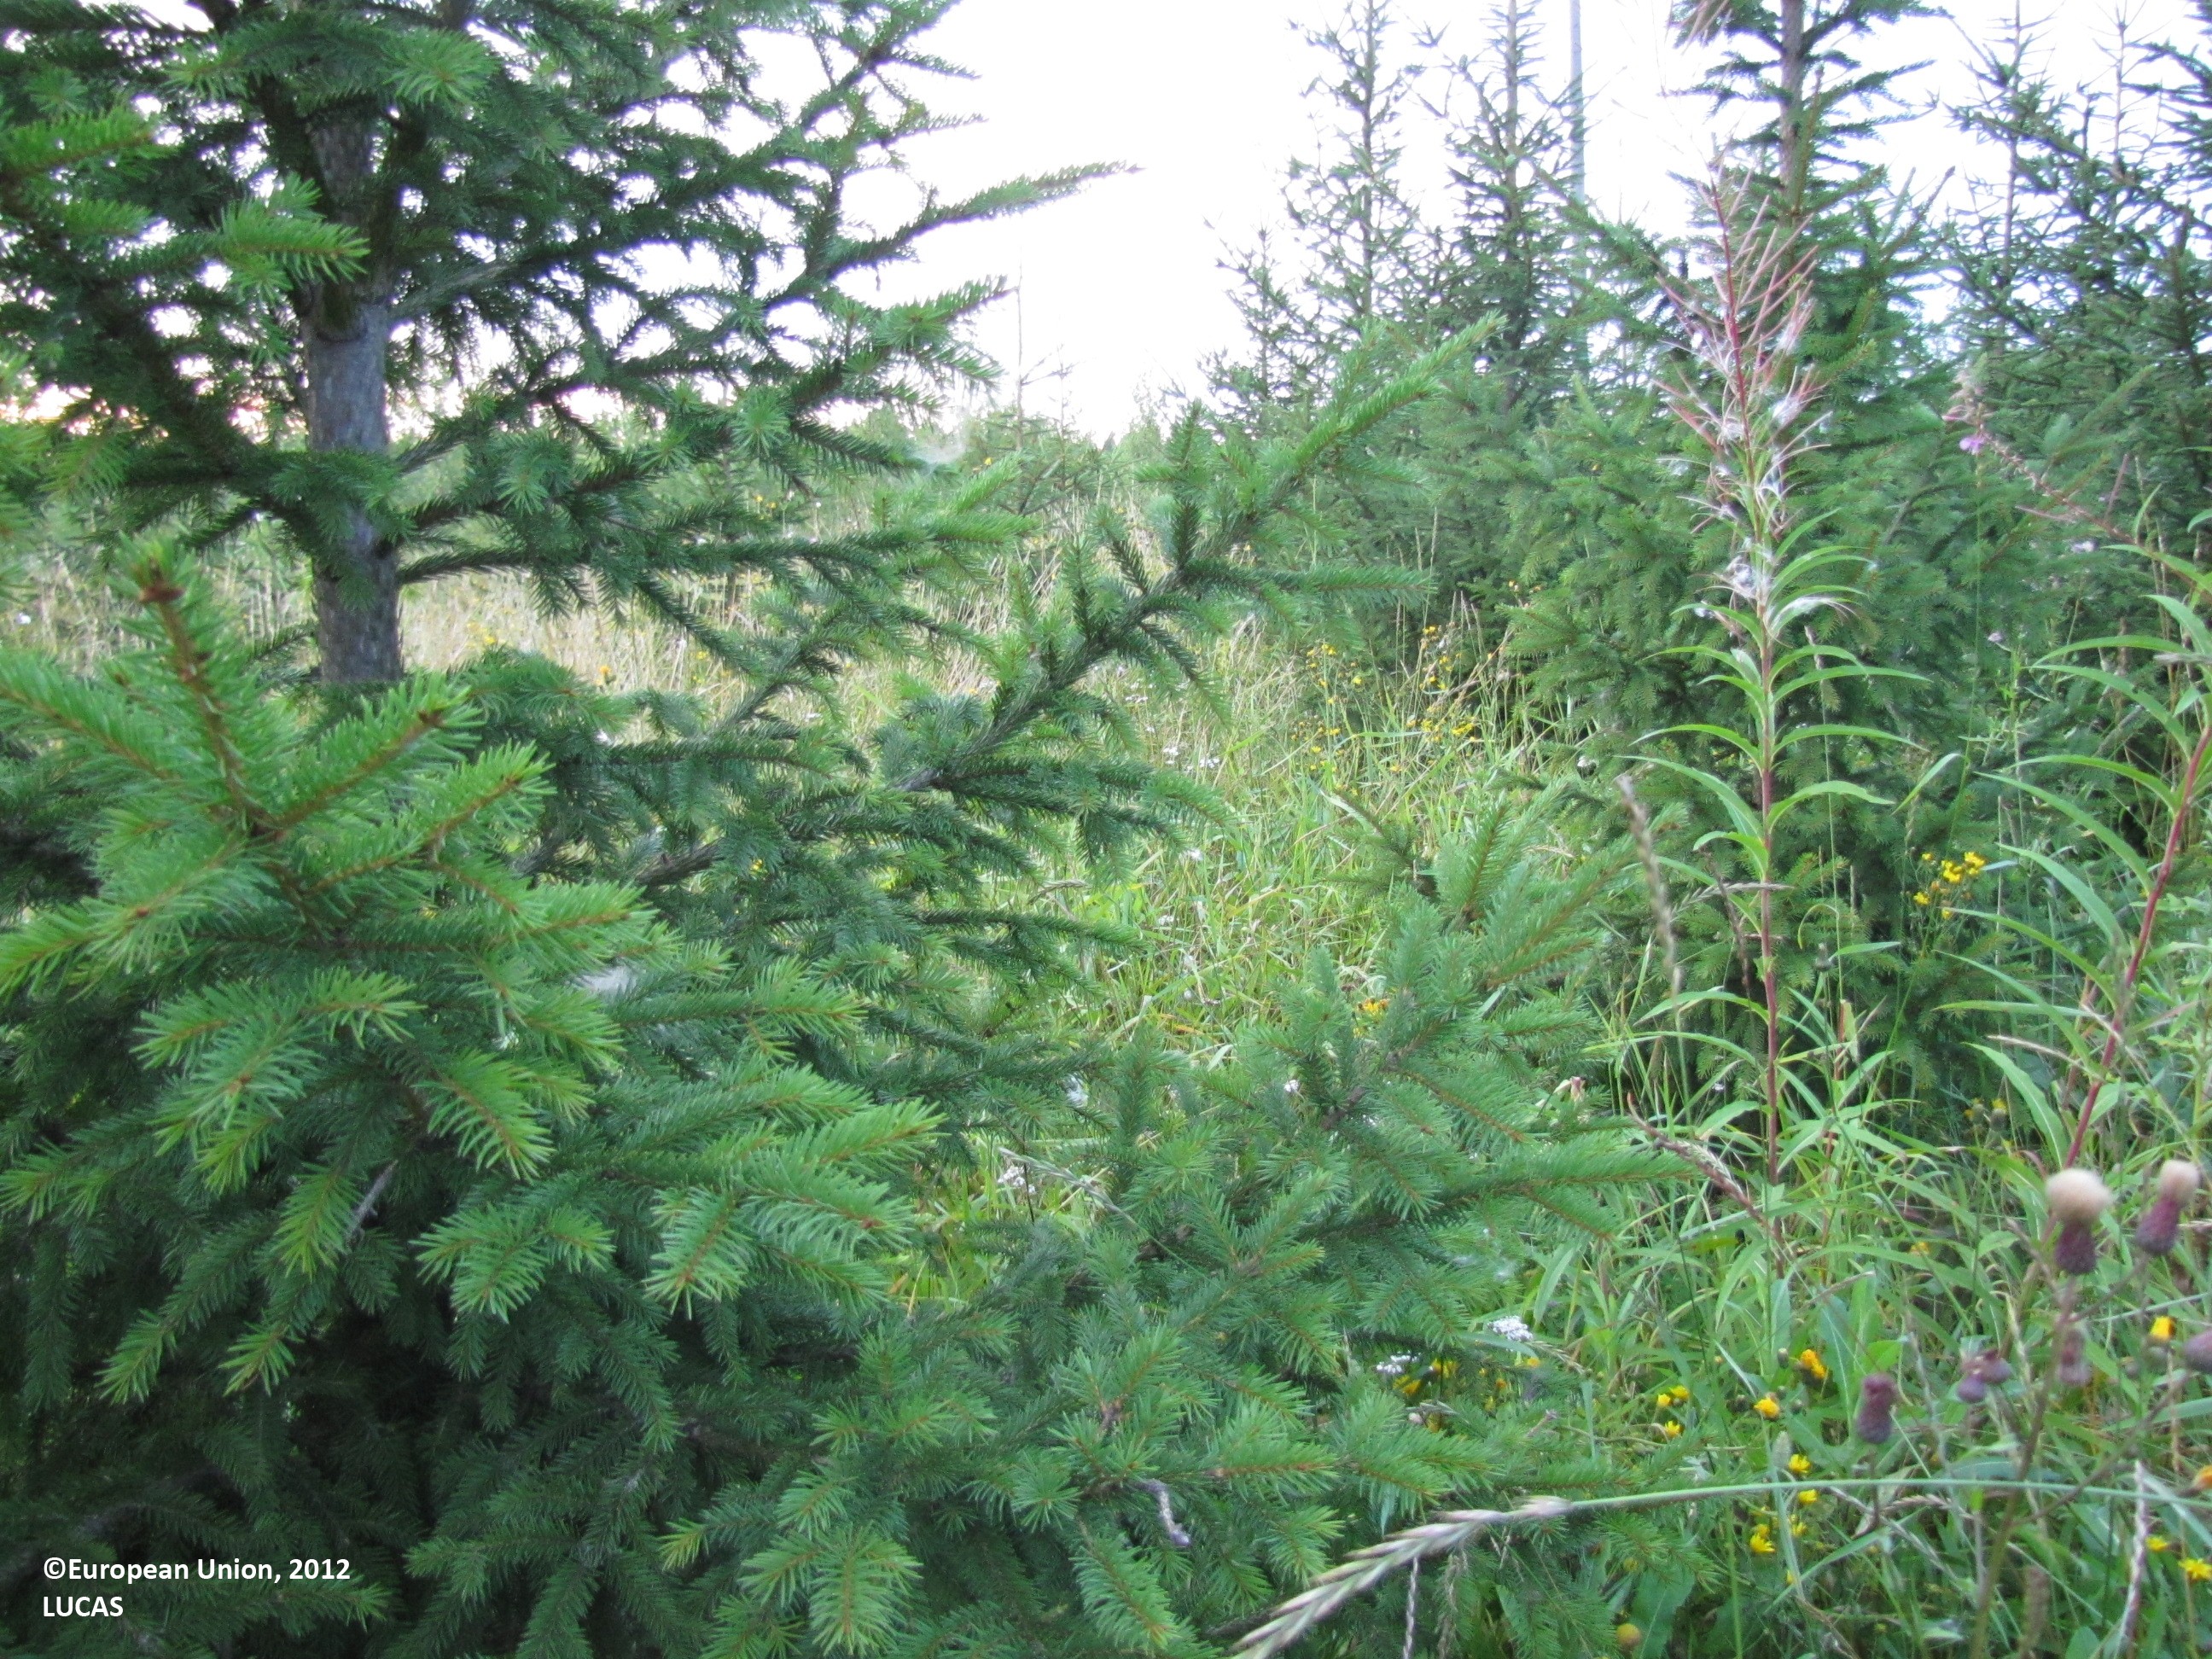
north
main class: Woodland
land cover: Spruce dominated coniferous woodland
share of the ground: 50 - 75 %
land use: Forestry
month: August
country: FI
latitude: 61.4412
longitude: 23.6014
